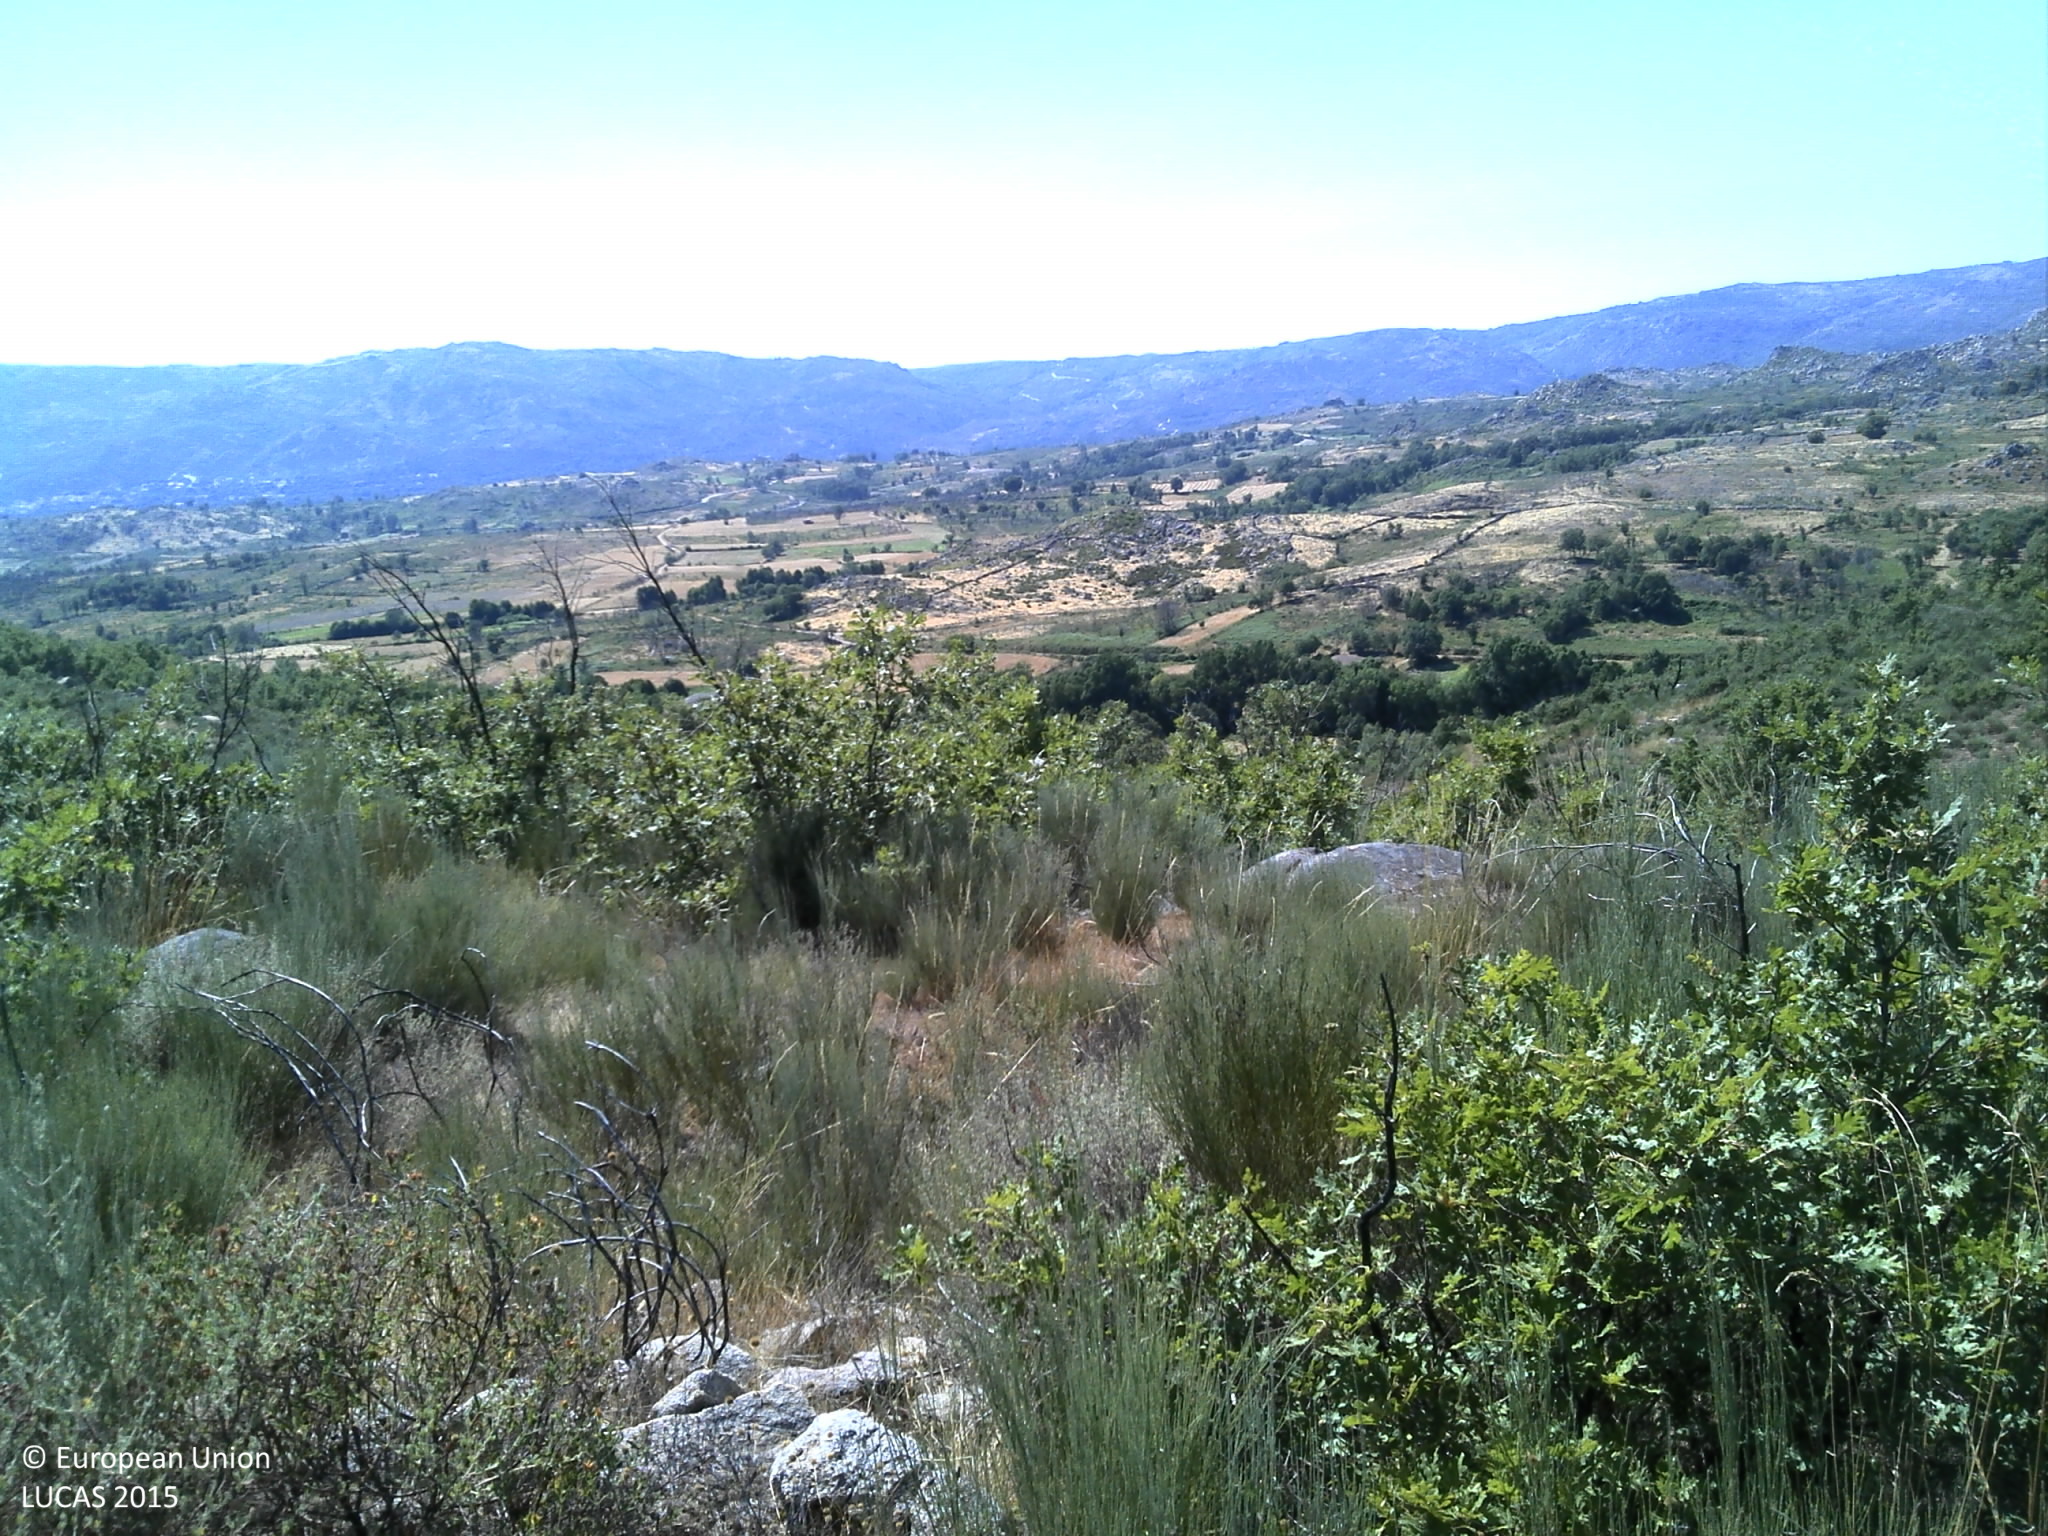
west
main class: Shrubland
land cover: Shrubland with sparse tree cover
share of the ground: > 75 %
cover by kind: shrubs 75 %, herbaceous plants 15 %, broadleaved forest trees 5 %, consolidated bare surface 5 %
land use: Agriculture (excluding fallow land and kitchen gardens)
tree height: < 5 m
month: July
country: PT
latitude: 41.7514
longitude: -7.5585
